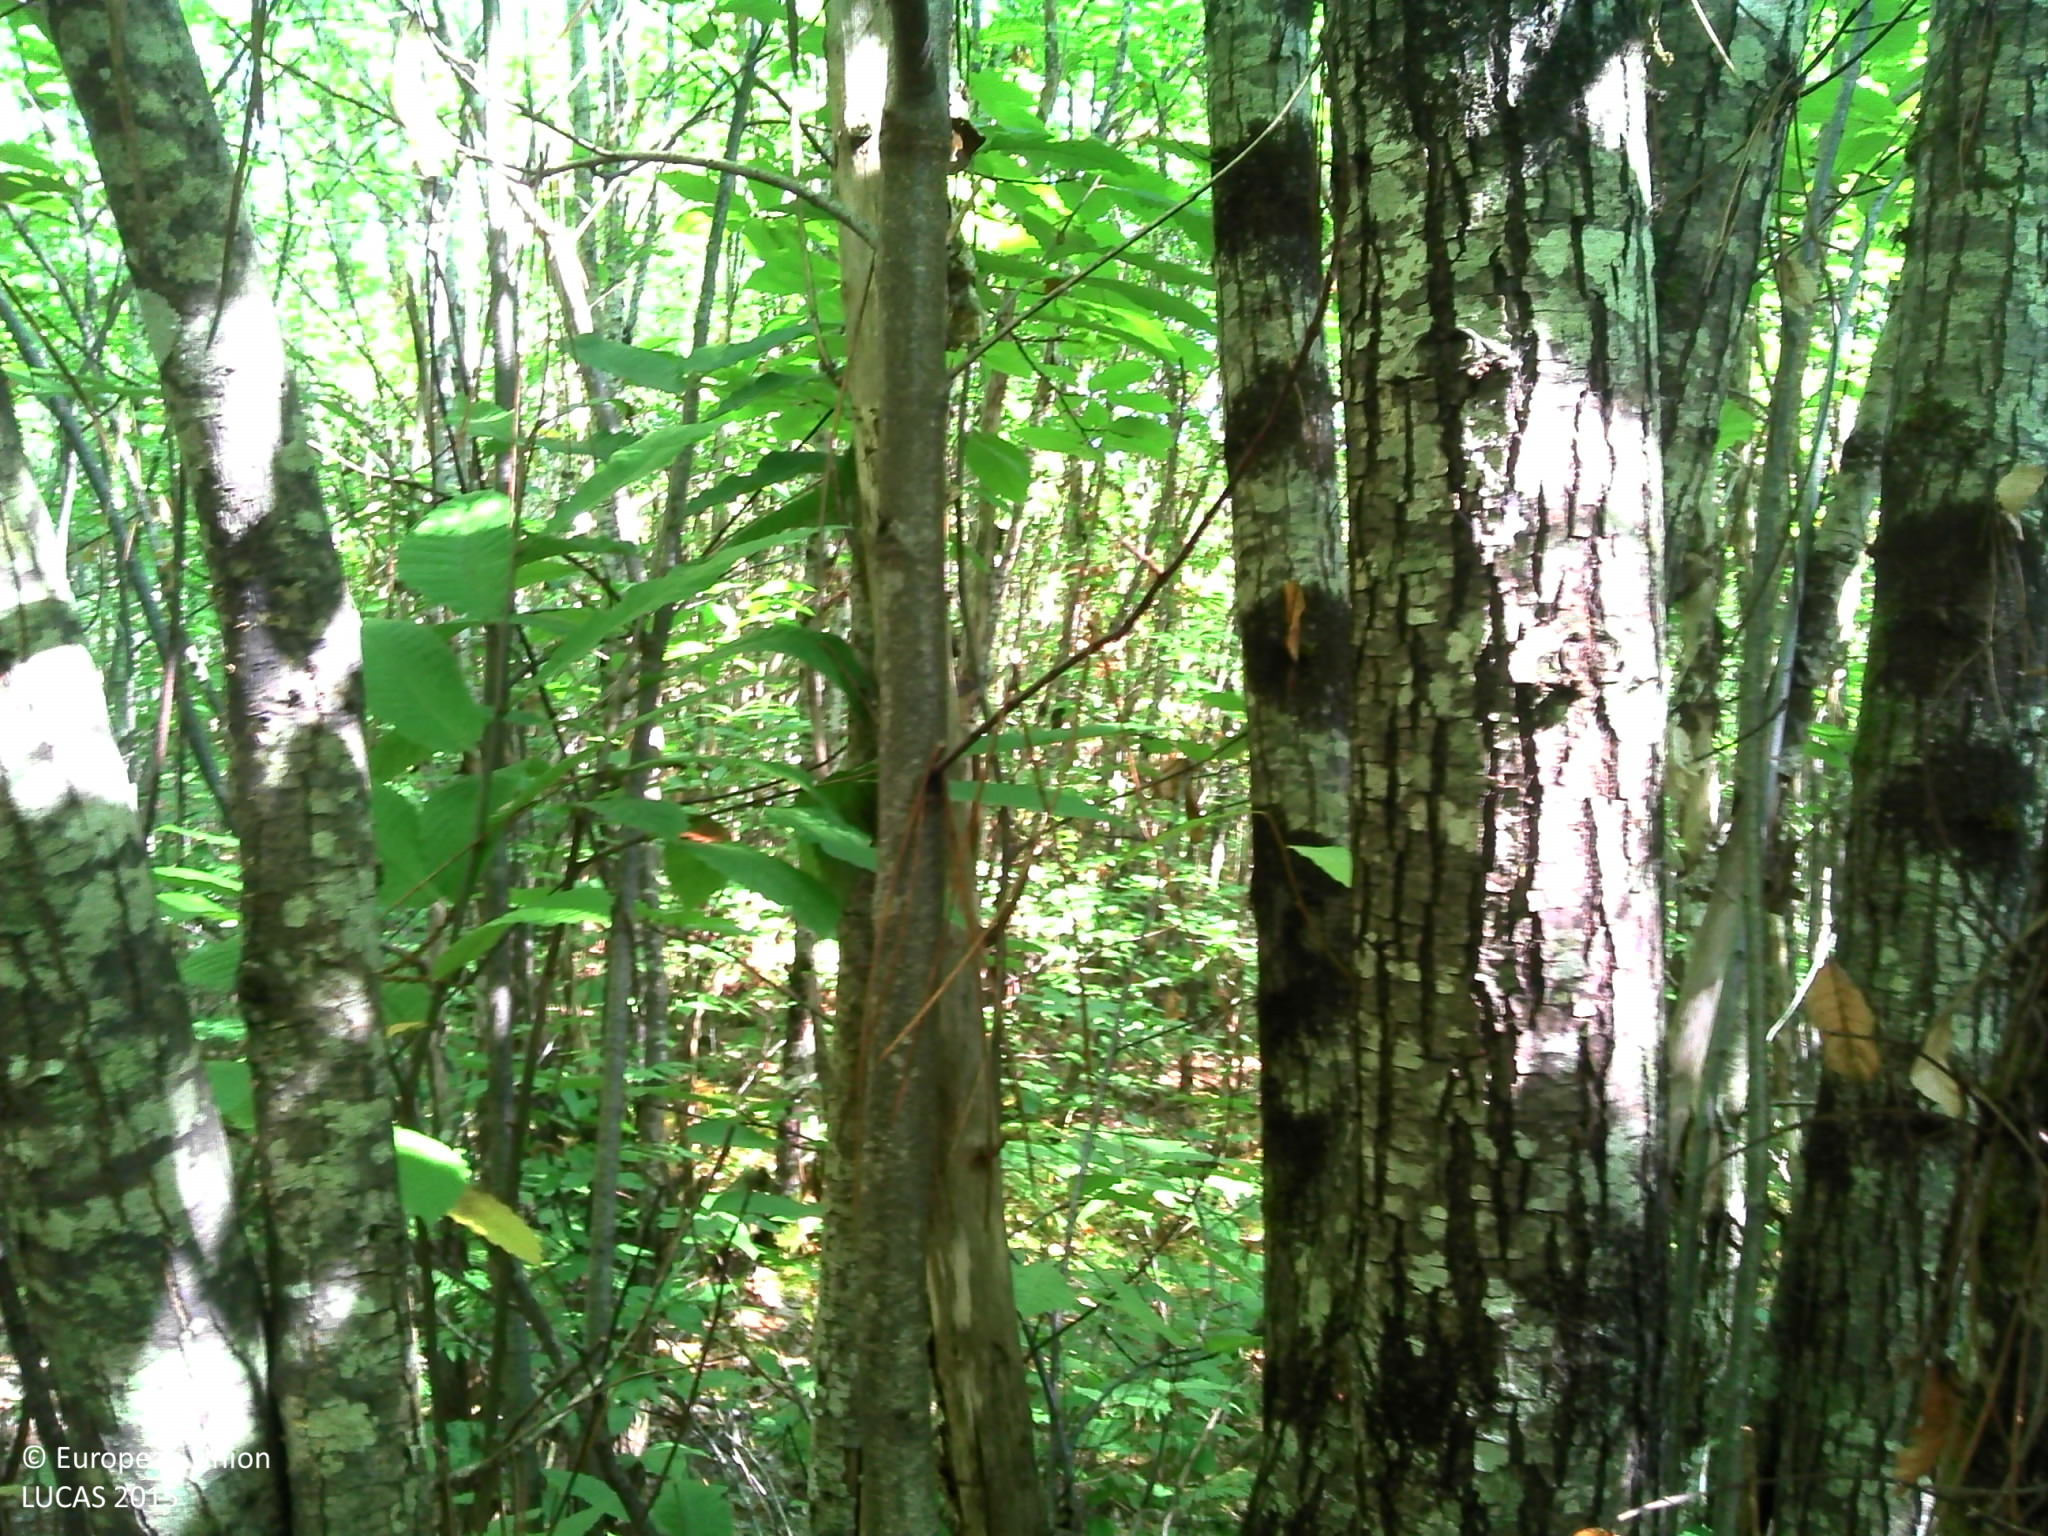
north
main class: Woodland
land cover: Pine dominated mixed woodland
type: thermophilous deciduous forest
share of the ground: > 75 %
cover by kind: broadleaved forest trees 40 %, coniferous forest trees 30 %, herbaceous plants 20 %, shrubs 5 %, consolidated bare surface 5 %
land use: Forestry
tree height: > 5 m
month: August
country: FR
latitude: 45.1420
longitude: 0.4376
